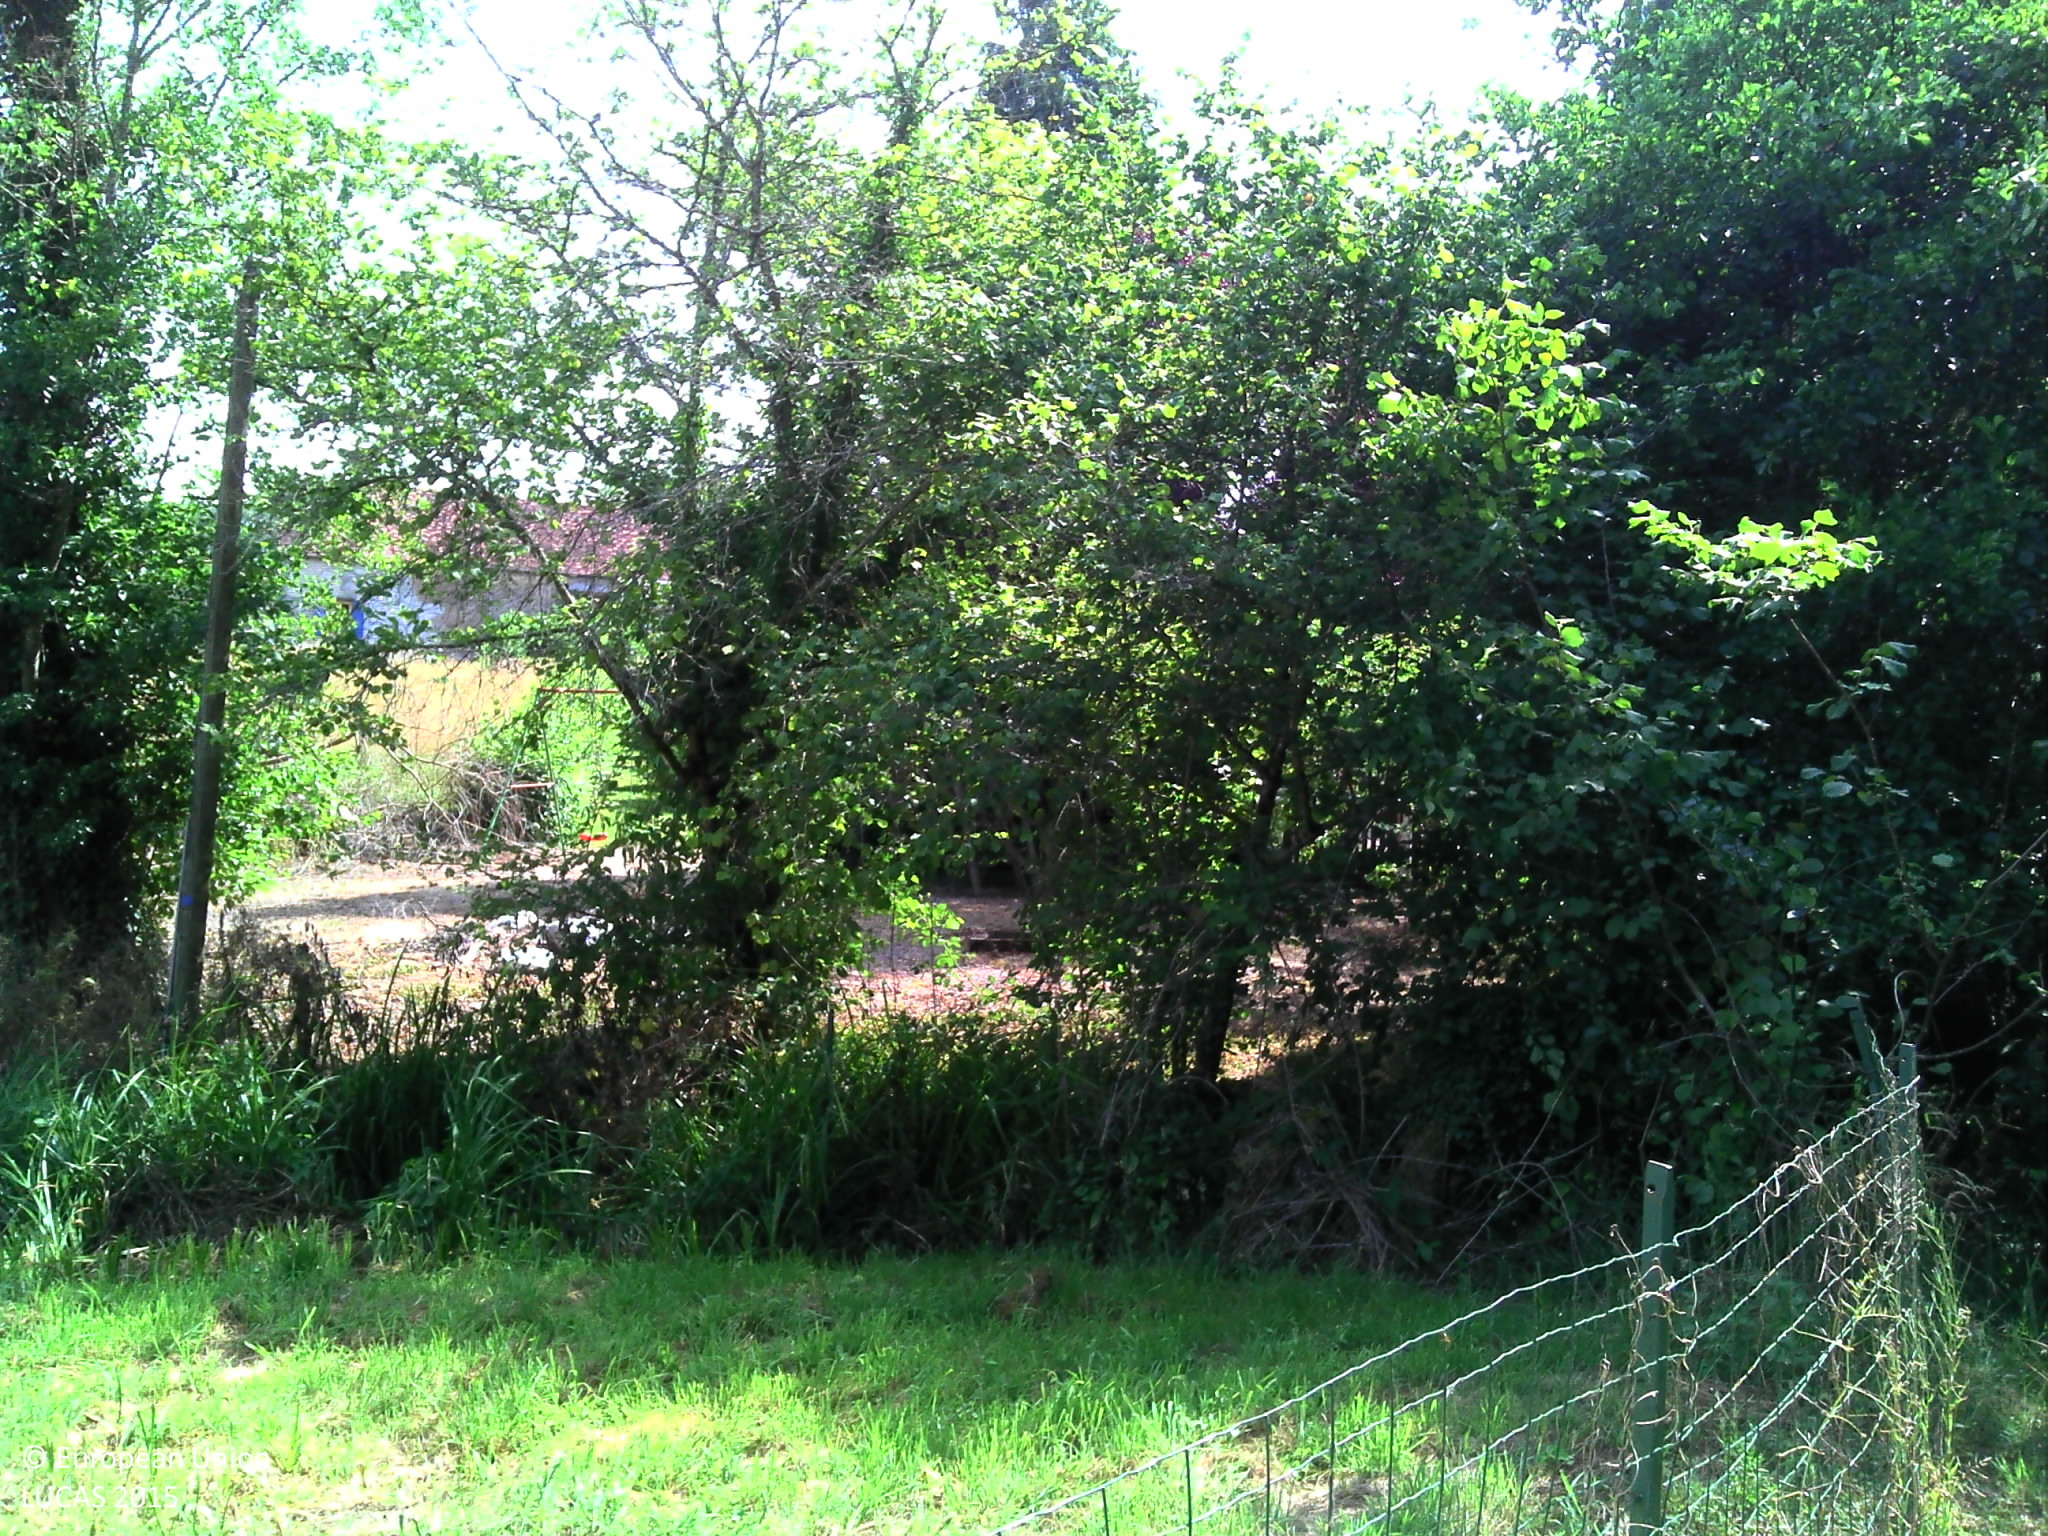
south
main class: Grassland
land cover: Grassland without tree/shrub cover
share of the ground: > 75 %
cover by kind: herbaceous plants 100 %
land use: Agriculture (excluding fallow land and kitchen gardens)
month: July
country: FR
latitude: 47.0407
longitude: 3.5354
